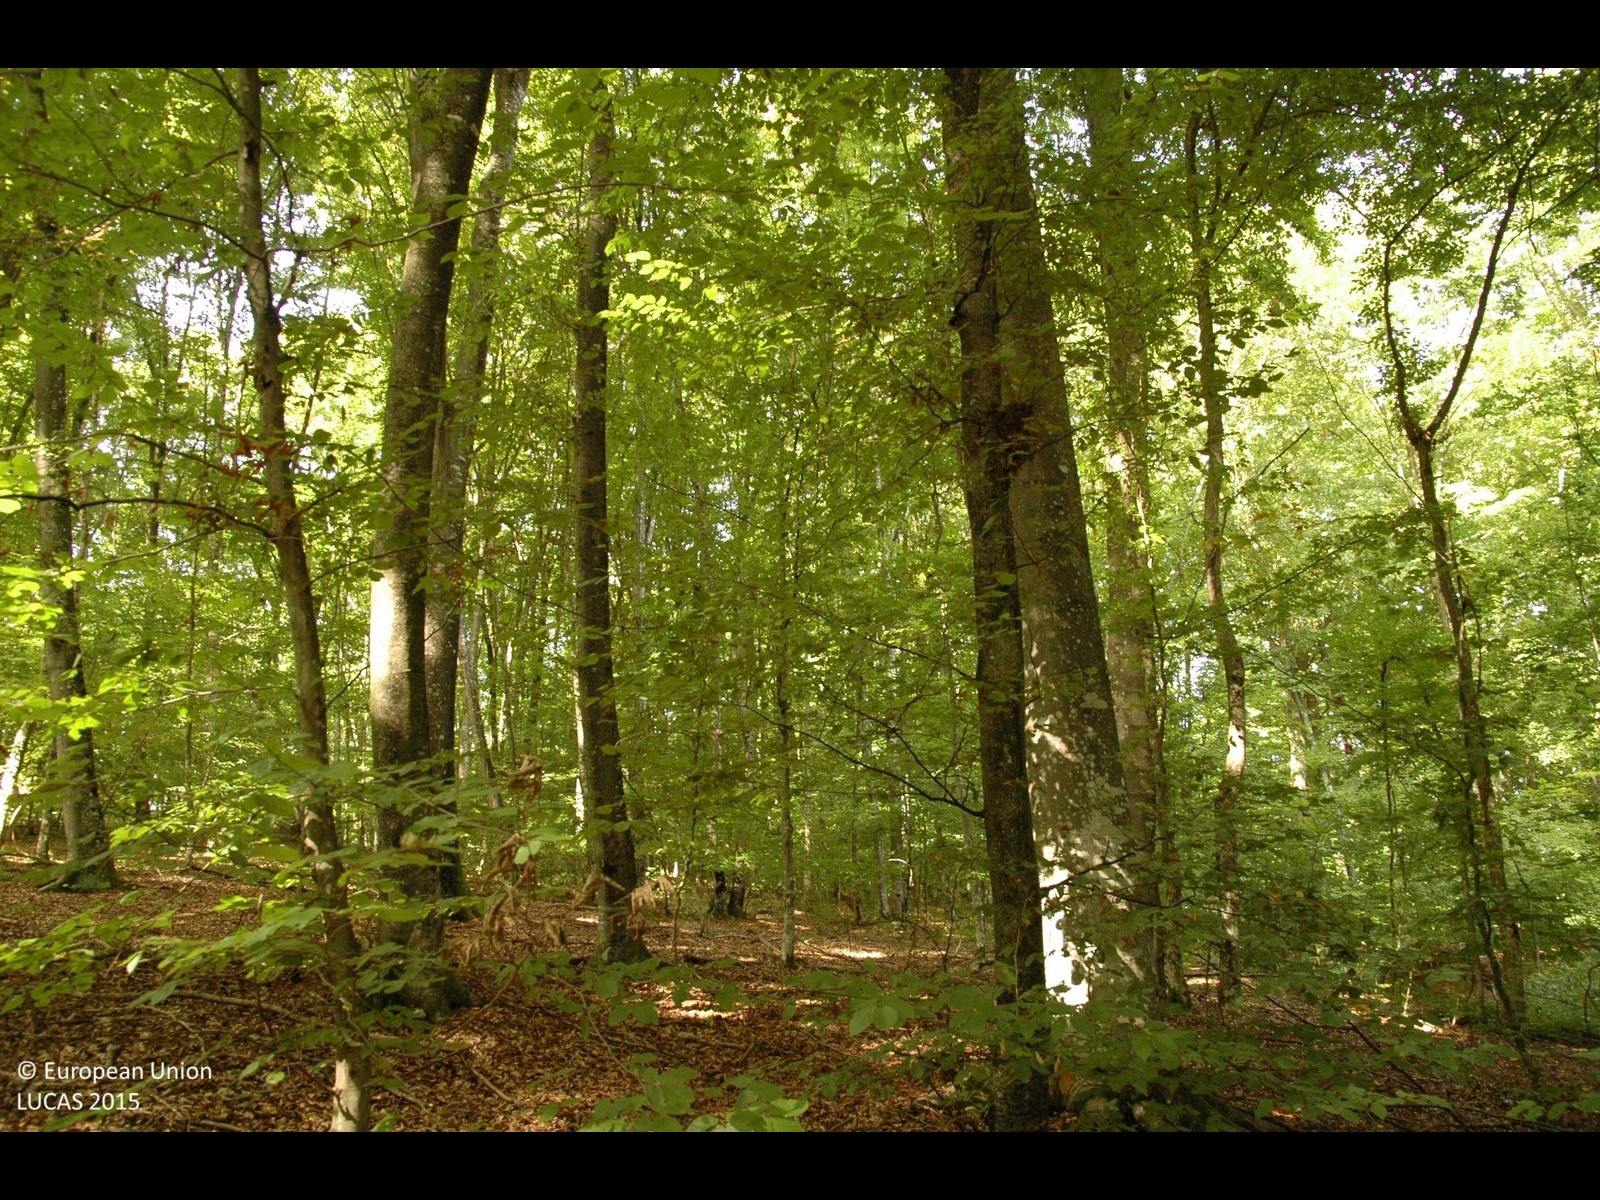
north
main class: Woodland
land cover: Broadleaved woodland
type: beech forest
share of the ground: > 75 %
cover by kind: broadleaved forest trees 100 %
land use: Forestry
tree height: > 5 m
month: September
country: HR
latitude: 45.5934
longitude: 15.8809
